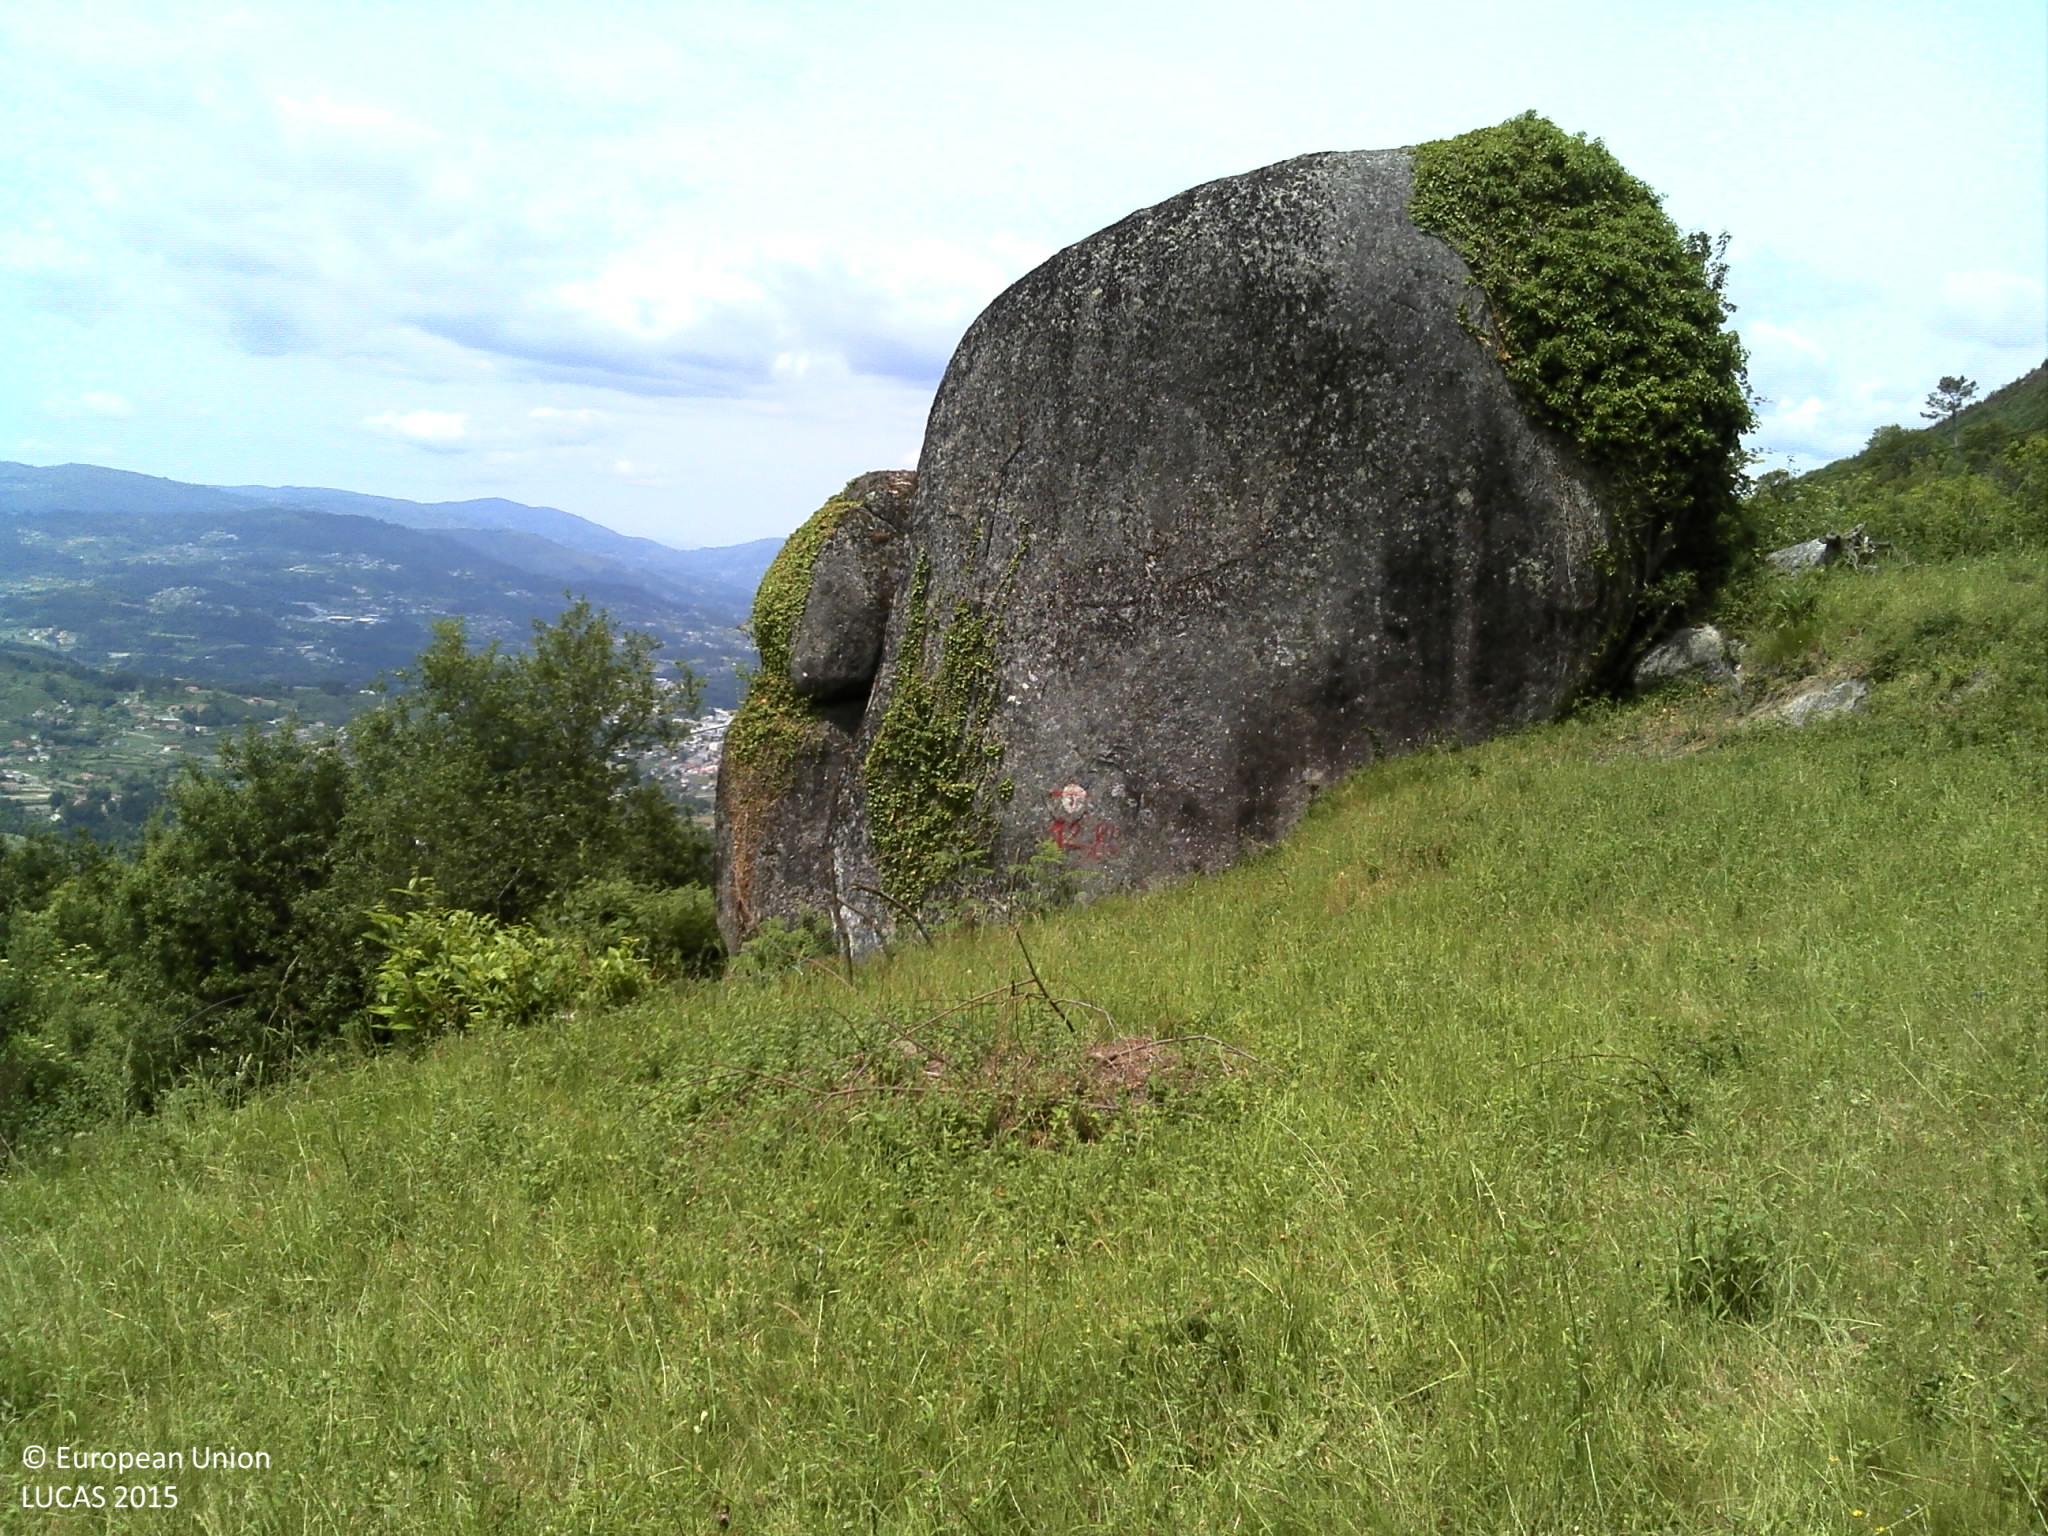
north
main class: Grassland
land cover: Grassland without tree/shrub cover
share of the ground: > 75 %
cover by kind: herbaceous plants 90 %, shrubs 5 %, consolidated bare surface 5 %
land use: Agriculture (excluding fallow land and kitchen gardens)
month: June
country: PT
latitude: 41.7633
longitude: -8.4037
